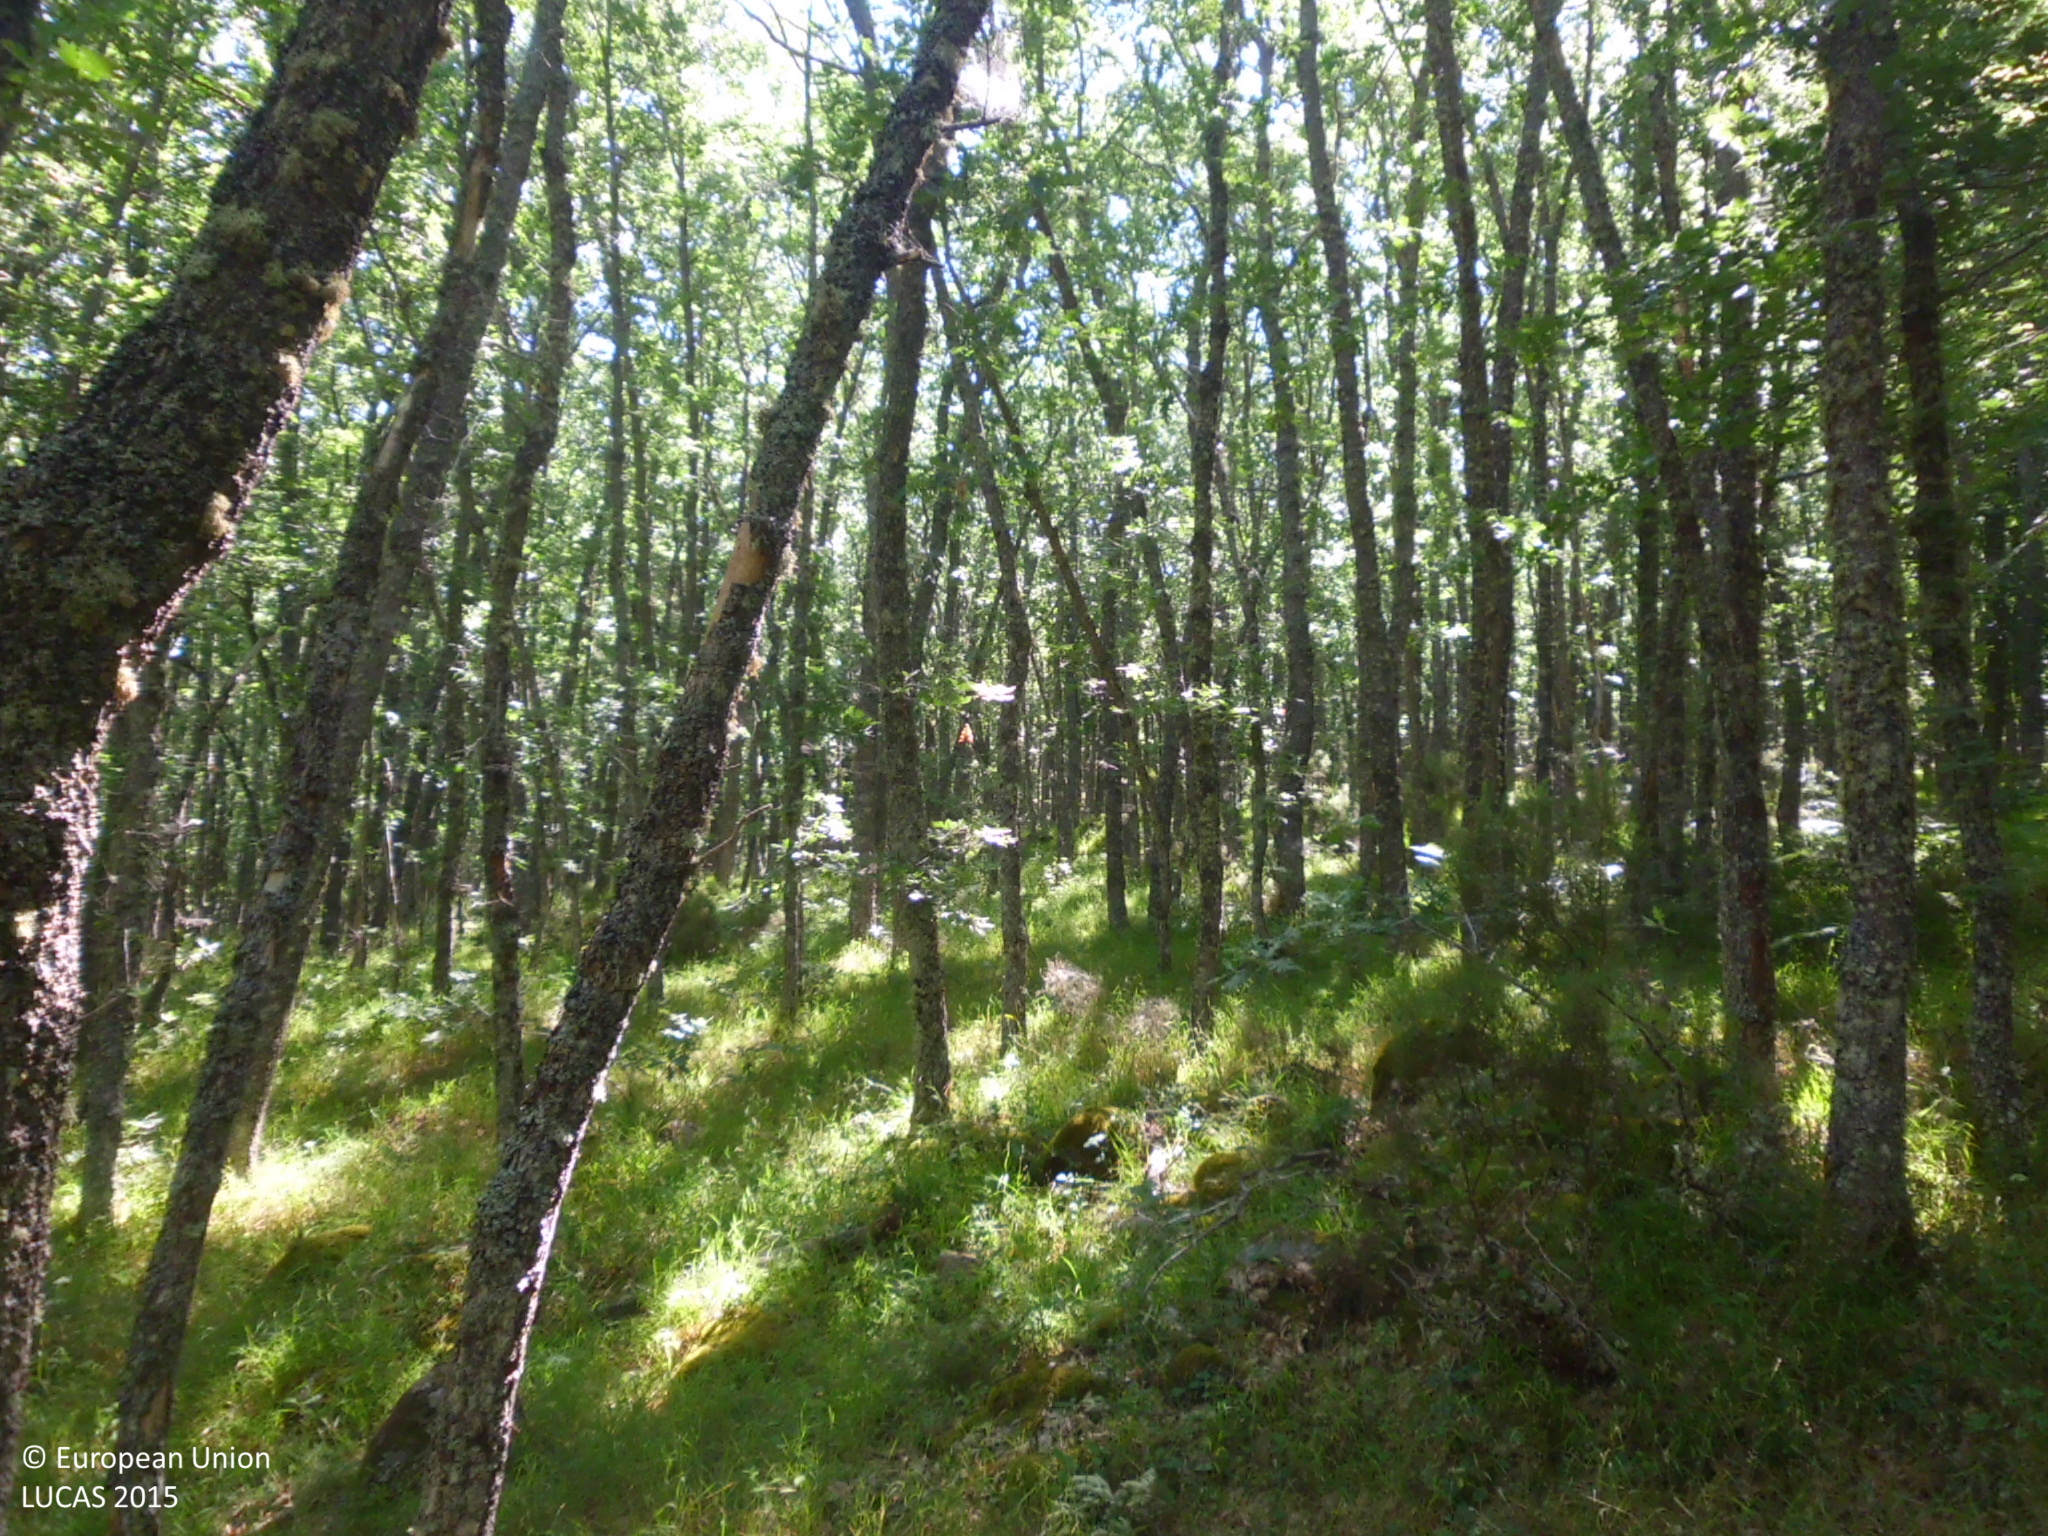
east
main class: Woodland
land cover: Broadleaved woodland
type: acidophilous oak and oak-birch forest
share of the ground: > 75 %
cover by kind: broadleaved forest trees 100 %
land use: Semi-natural and natural areas not in use
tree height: > 5 m
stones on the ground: 10 - 25 %
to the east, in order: Broadleaved woodland
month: July
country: ES
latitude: 42.2268
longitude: -3.3207
